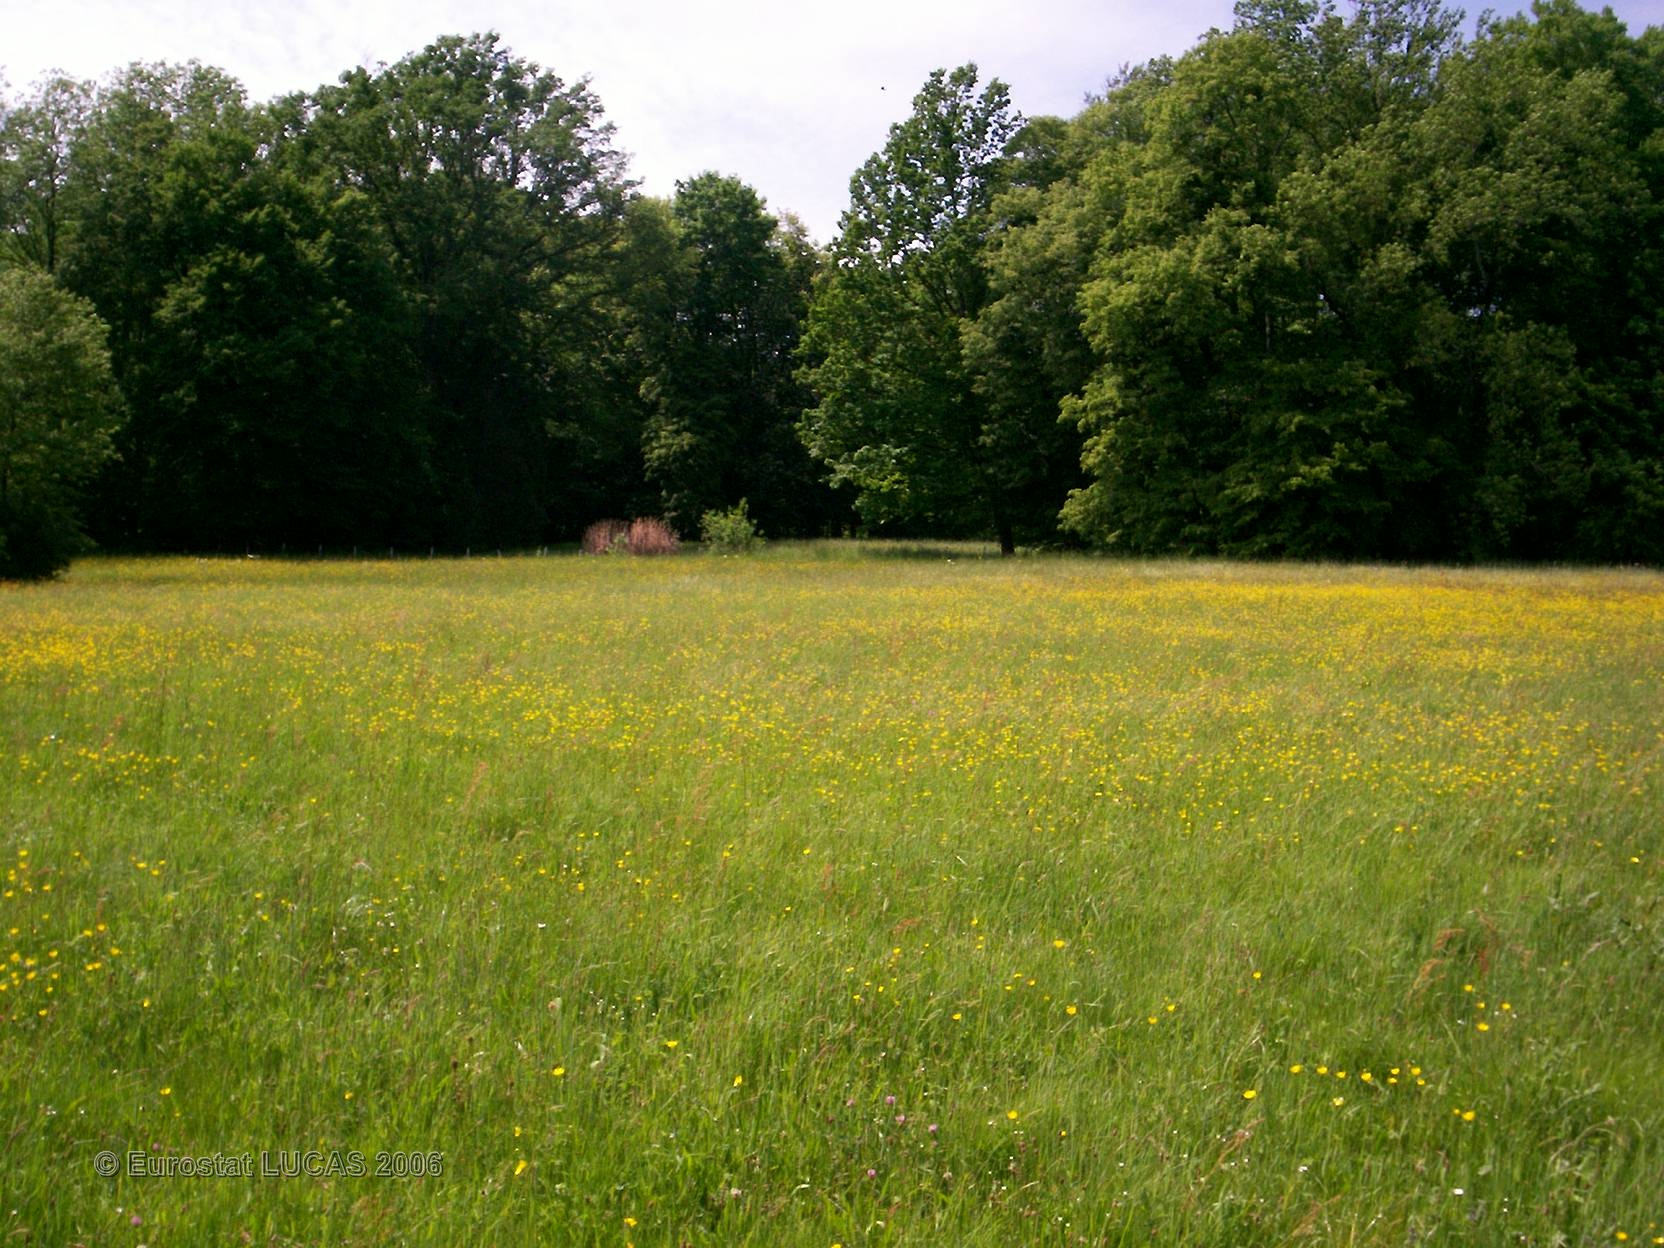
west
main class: Grassland
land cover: Grassland without tree/shrub cover
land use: Agriculture (excluding fallow land and kitchen gardens)
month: May
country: FR
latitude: 46.6667
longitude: 5.3884
